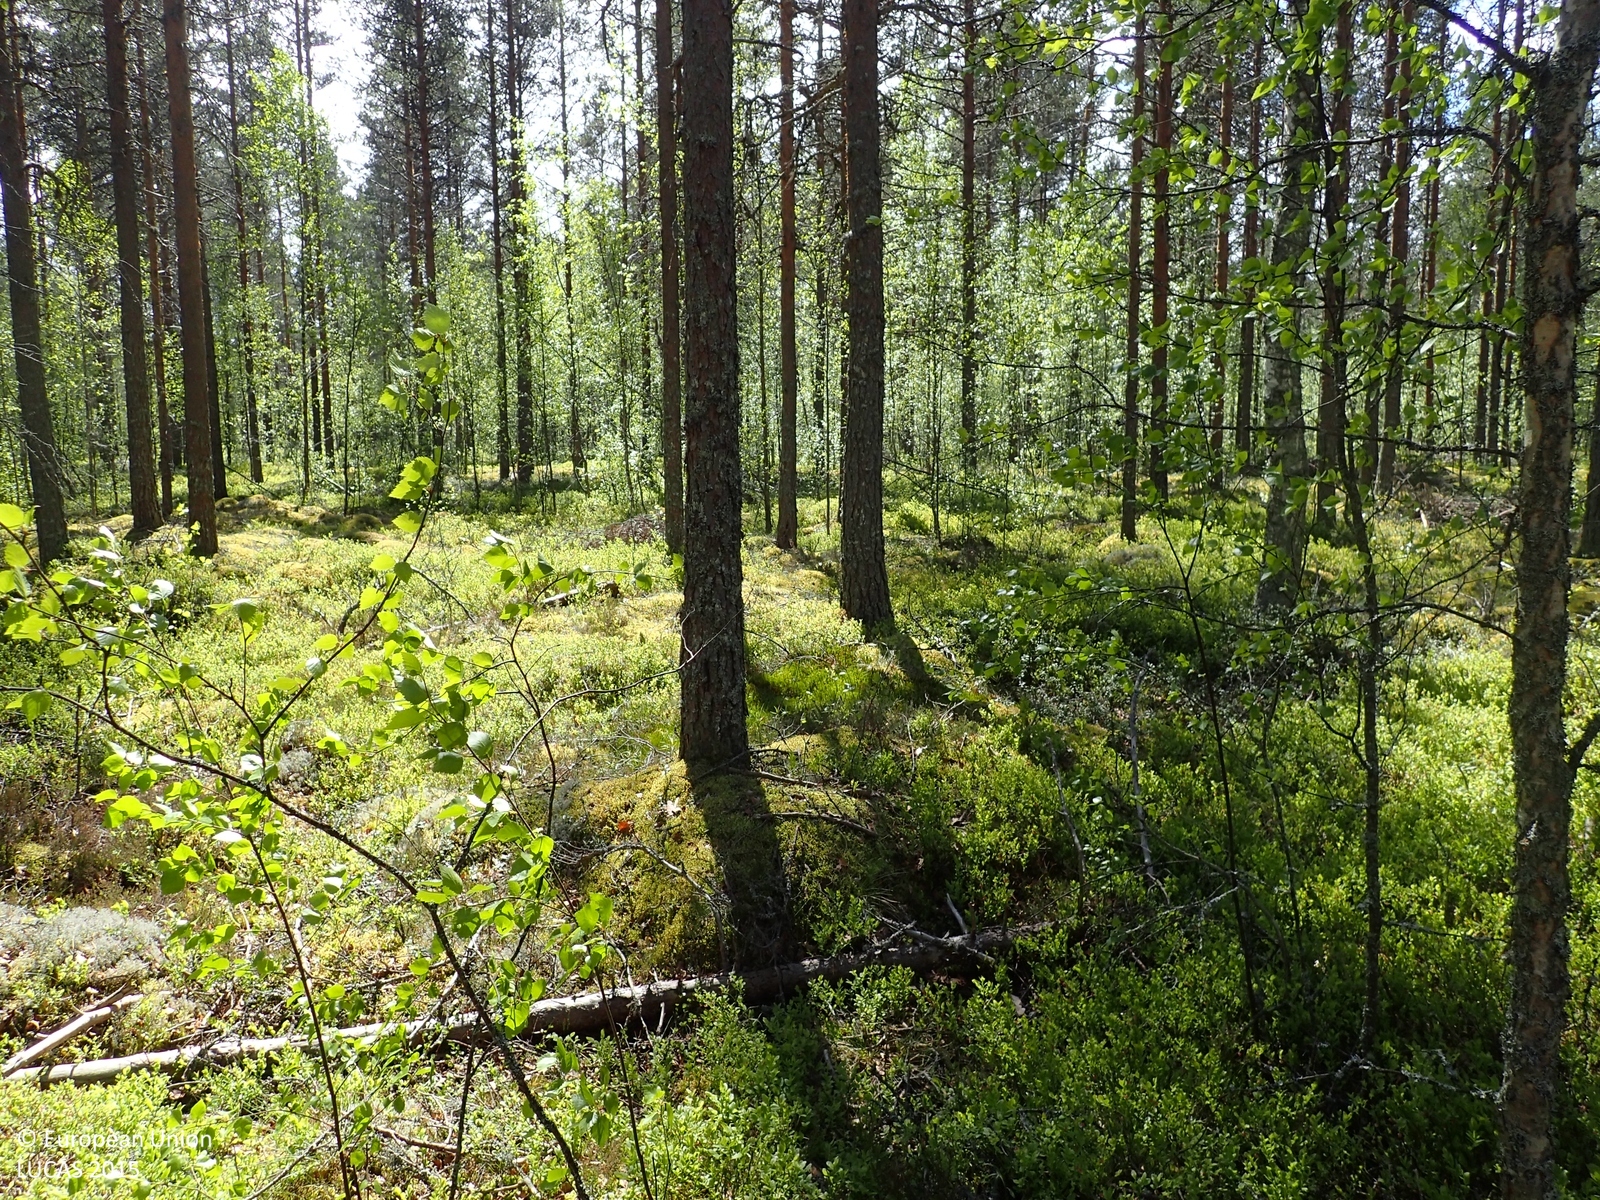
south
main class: Woodland
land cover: Pine dominated coniferous woodland
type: boreal forest
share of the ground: > 75 %
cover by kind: coniferous forest trees 60 %, broadleaved forest trees 20 %, shrubs 15 %, lichens and mosses 5 %
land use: Forestry
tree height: > 5 m
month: June
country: FI
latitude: 62.2184
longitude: 22.2668
